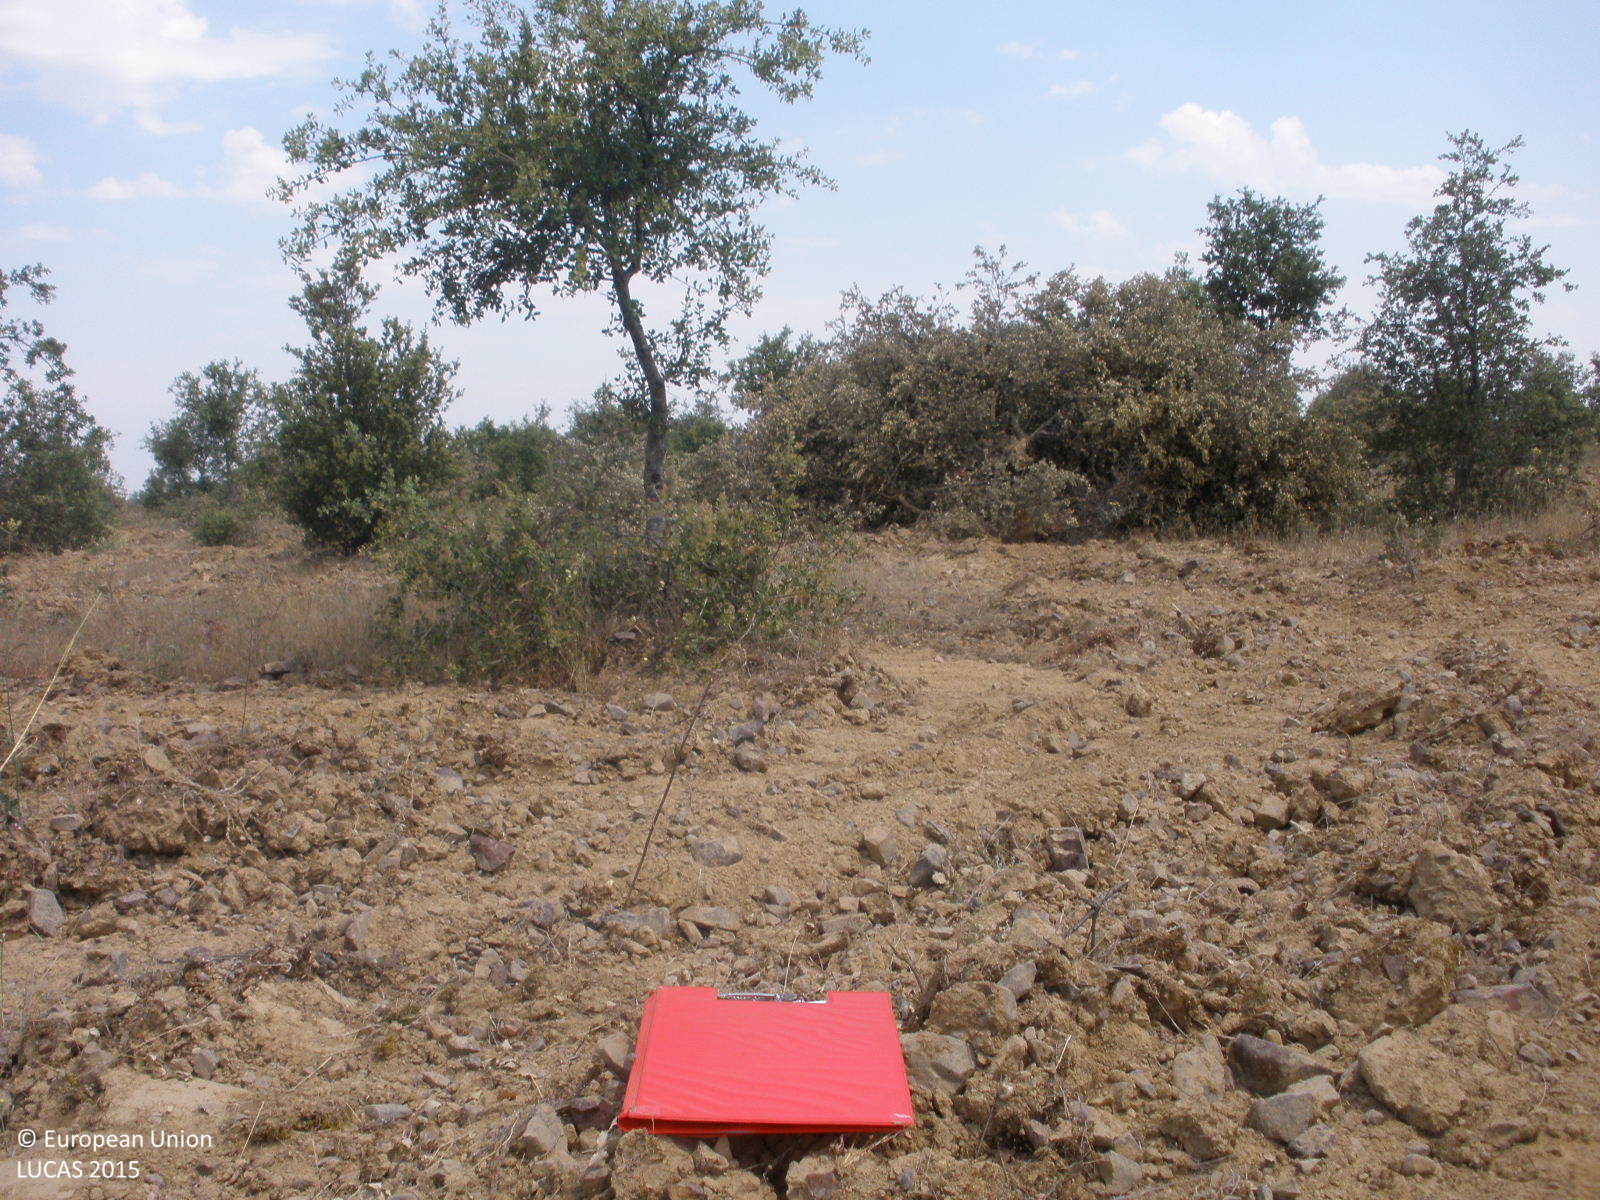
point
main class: Woodland
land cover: Broadleaved woodland
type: broadleaved evergreen forest
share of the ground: 50 - 75 %
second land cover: Spontaneously vegetated surfaces
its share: 25 - 50 %
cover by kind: broadleaved forest trees 50 %, unconsolidated bare surface 40 %, herbaceous plants 10 %
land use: Forestry
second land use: Fallow land
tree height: < 5 m
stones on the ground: > 50 %
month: June
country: ES
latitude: 40.6078
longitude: -6.2881
